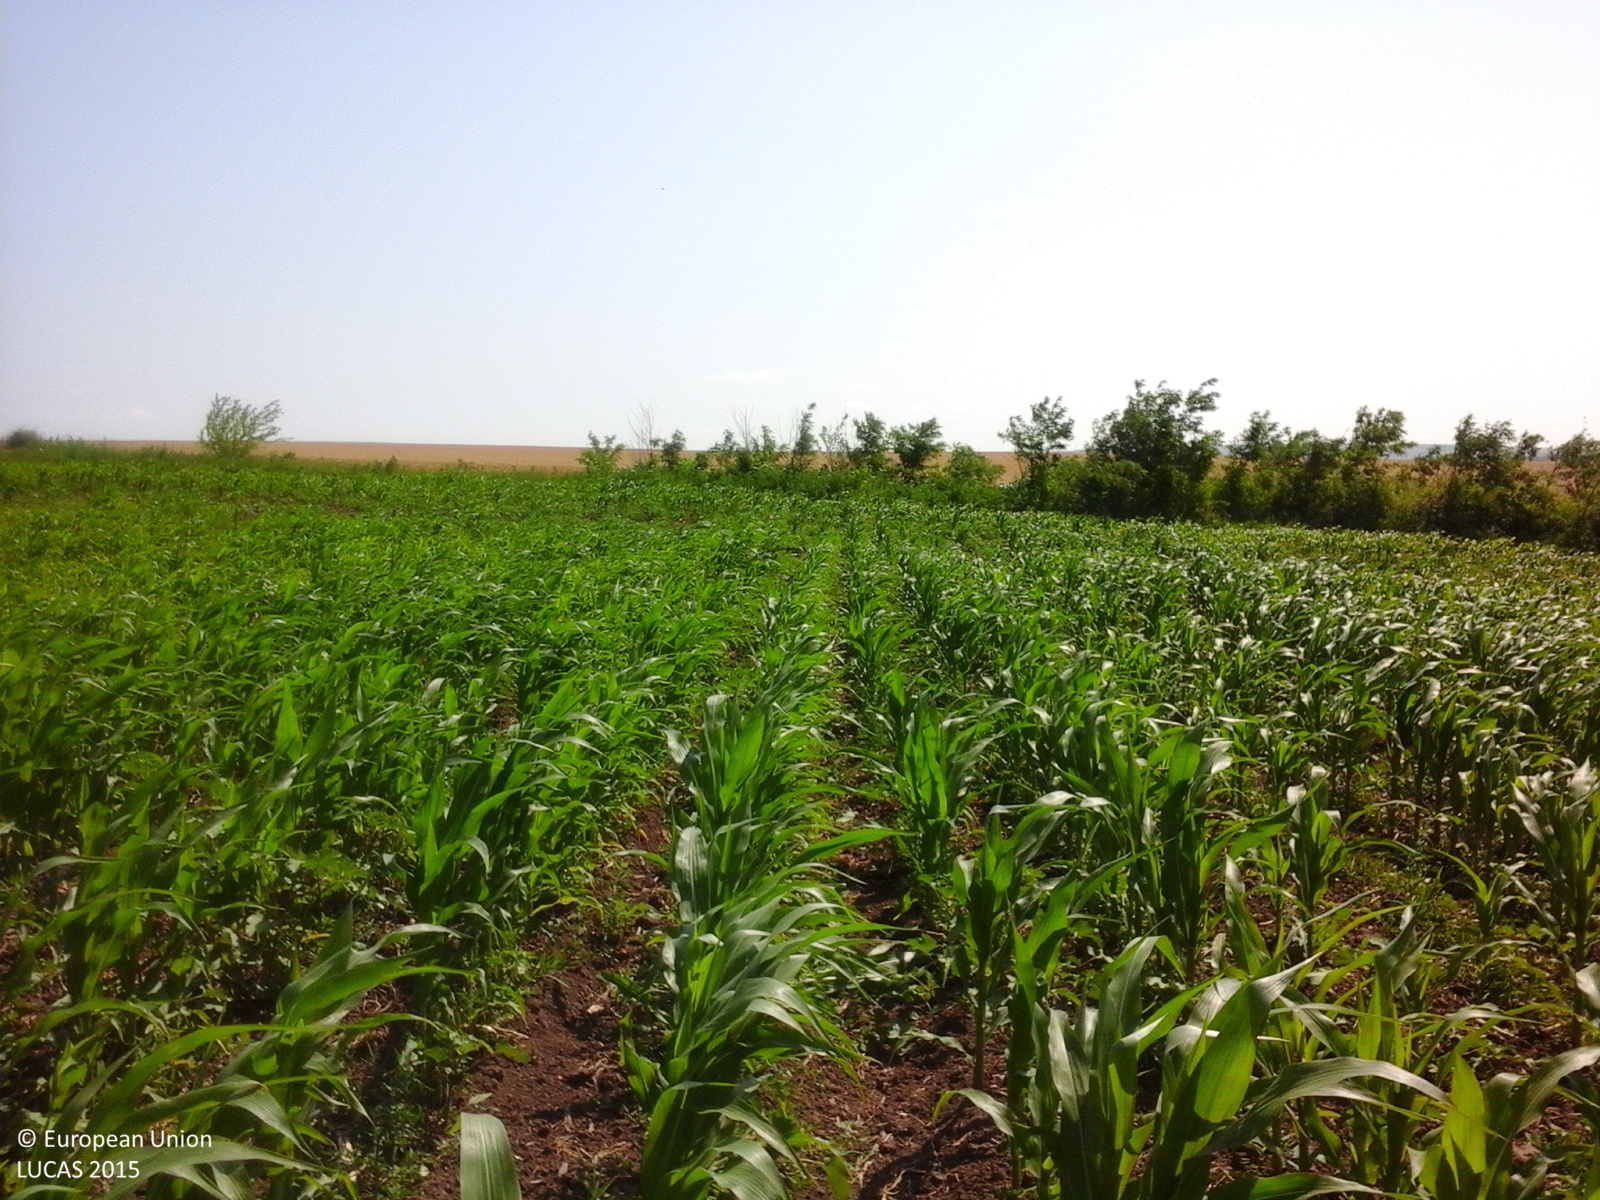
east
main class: Cropland
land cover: Maize
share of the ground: 50 - 75 %
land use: Agriculture (excluding fallow land and kitchen gardens)
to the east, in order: Maize; Abandoned hedges; Ditches and canals; Abandoned hedges; Tracks; Common wheat
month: June
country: RO
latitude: 46.7787
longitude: 27.0067
